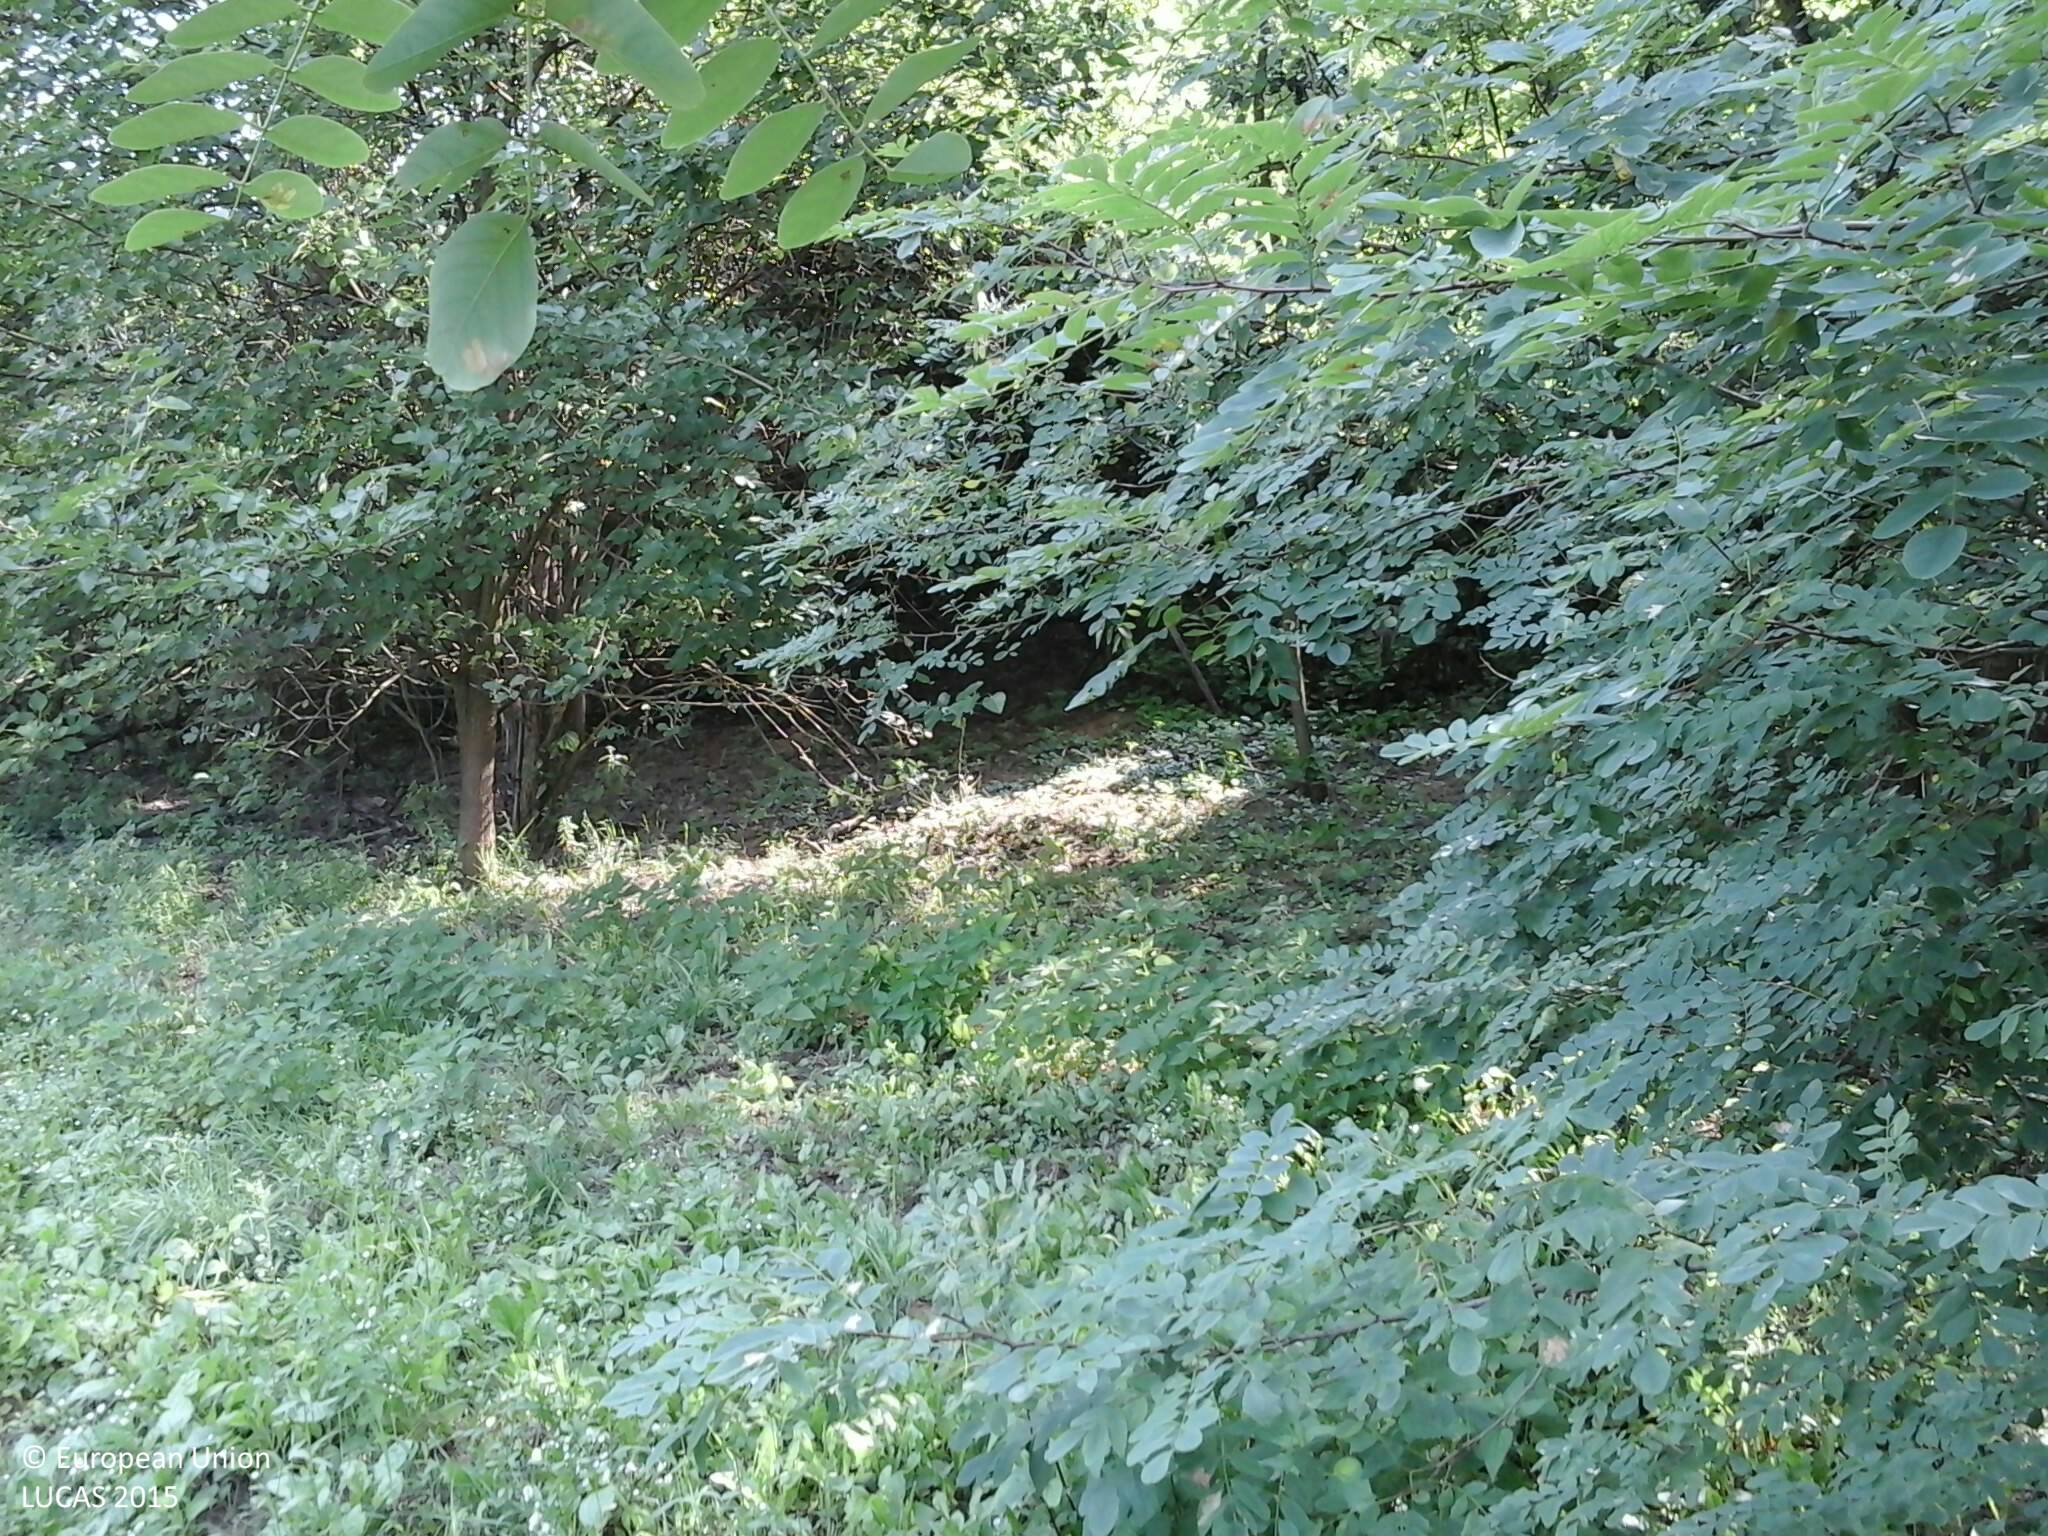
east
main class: Shrubland
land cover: Shrubland with sparse tree cover
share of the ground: > 75 %
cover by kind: herbaceous plants 75 %, shrubs 20 %, broadleaved forest trees 5 %
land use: Agriculture (excluding fallow land and kitchen gardens)
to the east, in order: Shrubland with sparse tree cover; Broadleaved woodland
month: August
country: HU
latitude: 48.3028
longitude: 20.6731
